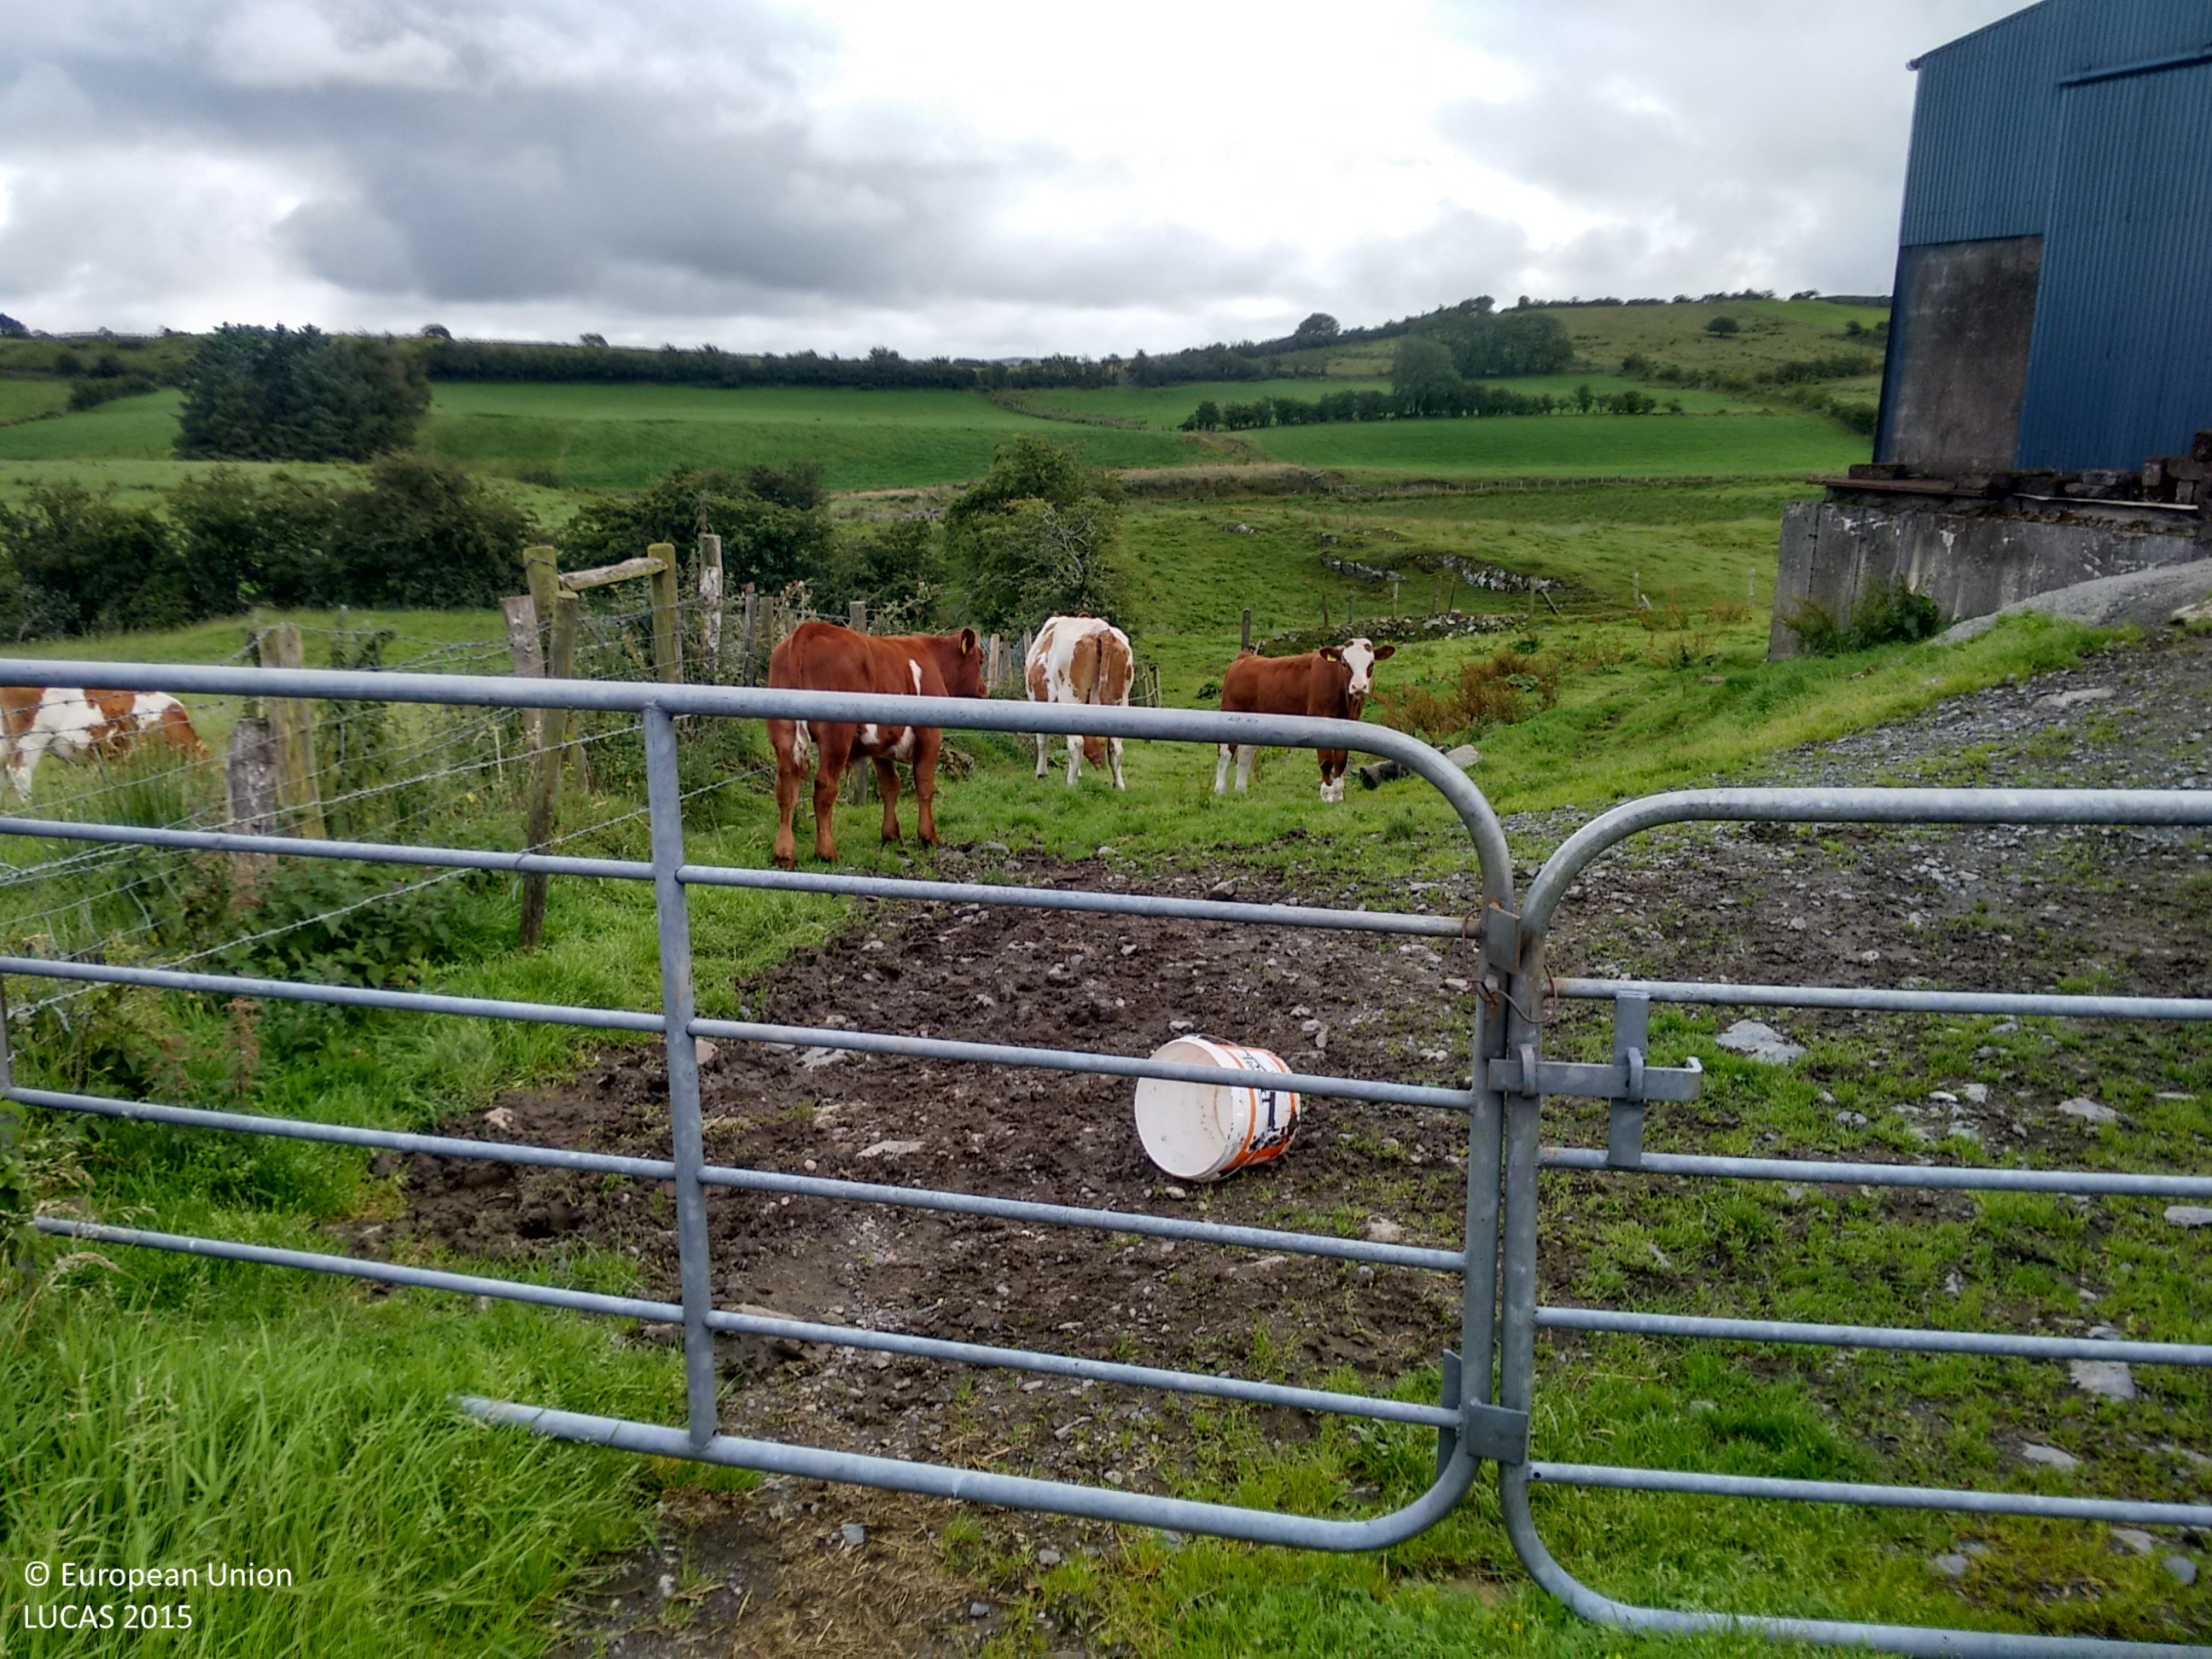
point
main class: Grassland
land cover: Grassland without tree/shrub cover
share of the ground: > 75 %
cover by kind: herbaceous plants 100 %
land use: Agriculture (excluding fallow land and kitchen gardens)
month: August
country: GB
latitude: 54.2152
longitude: -6.7084
